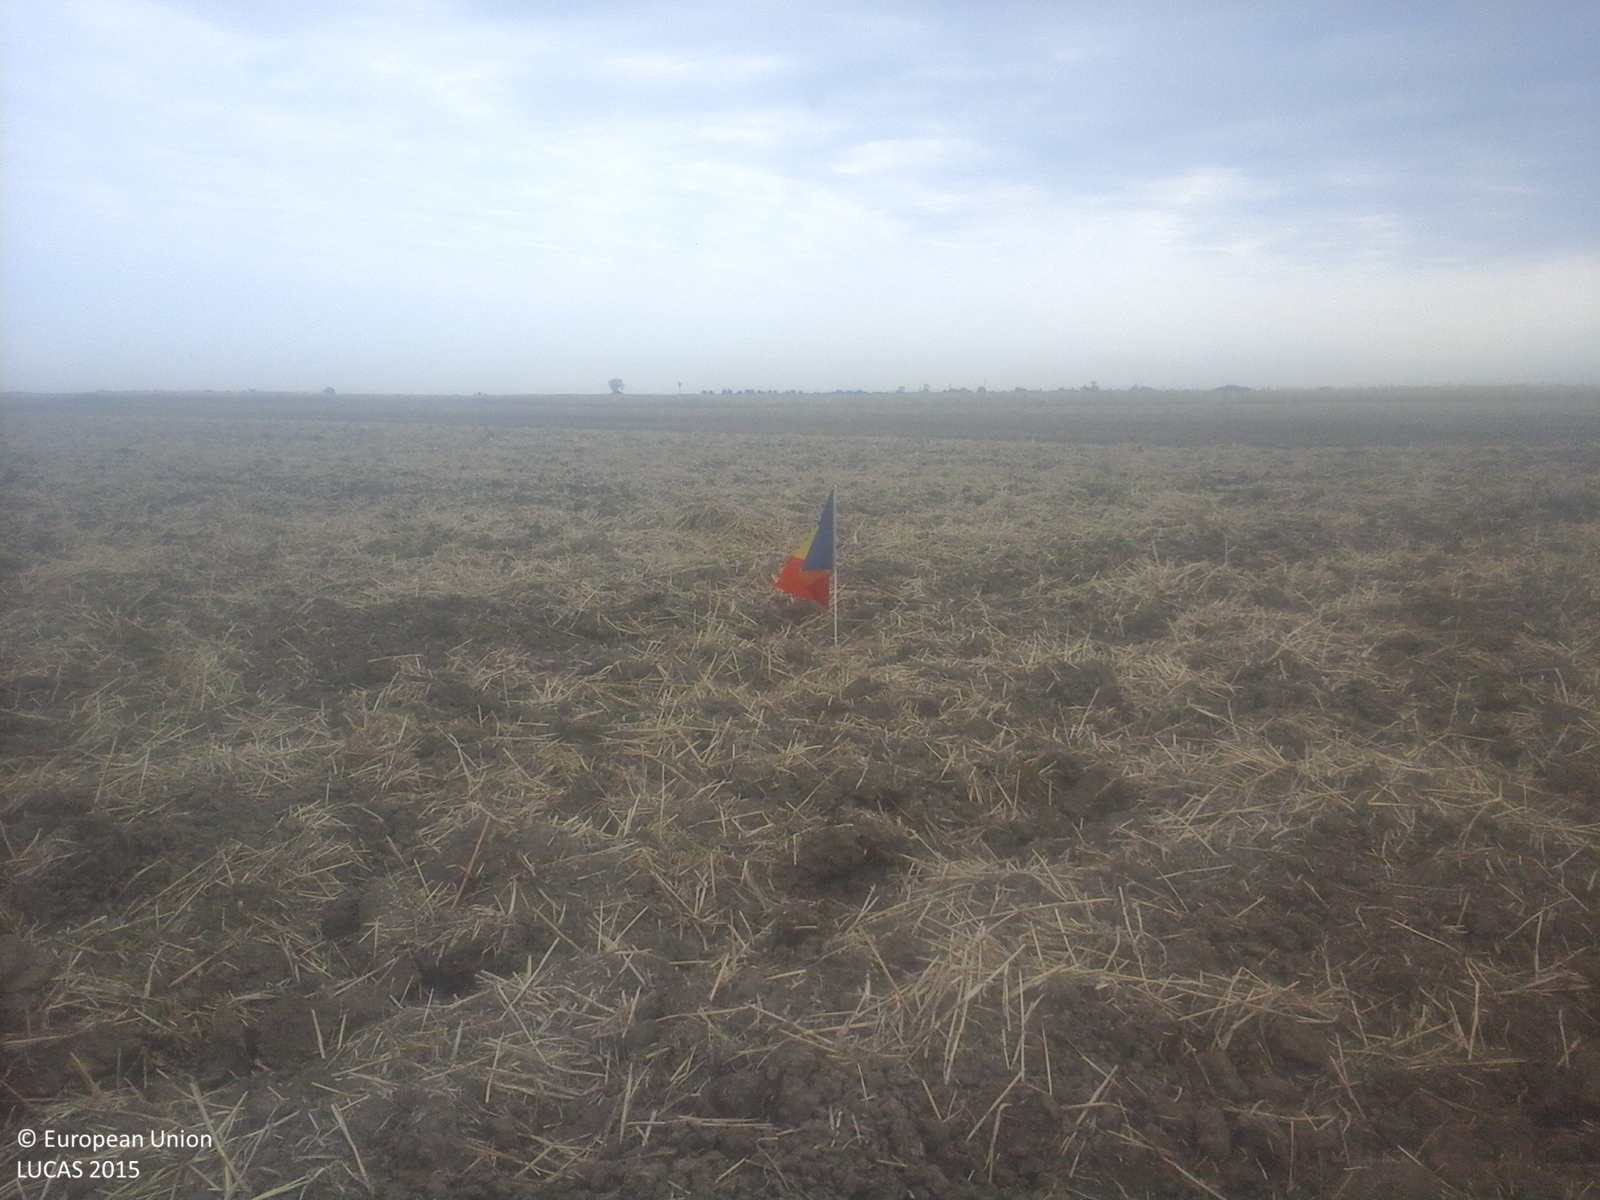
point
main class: Cropland
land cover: Common wheat
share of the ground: < 10 %
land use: Agriculture (excluding fallow land and kitchen gardens)
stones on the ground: < 10 %
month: September
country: RO
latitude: 47.7477
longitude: 22.6381
